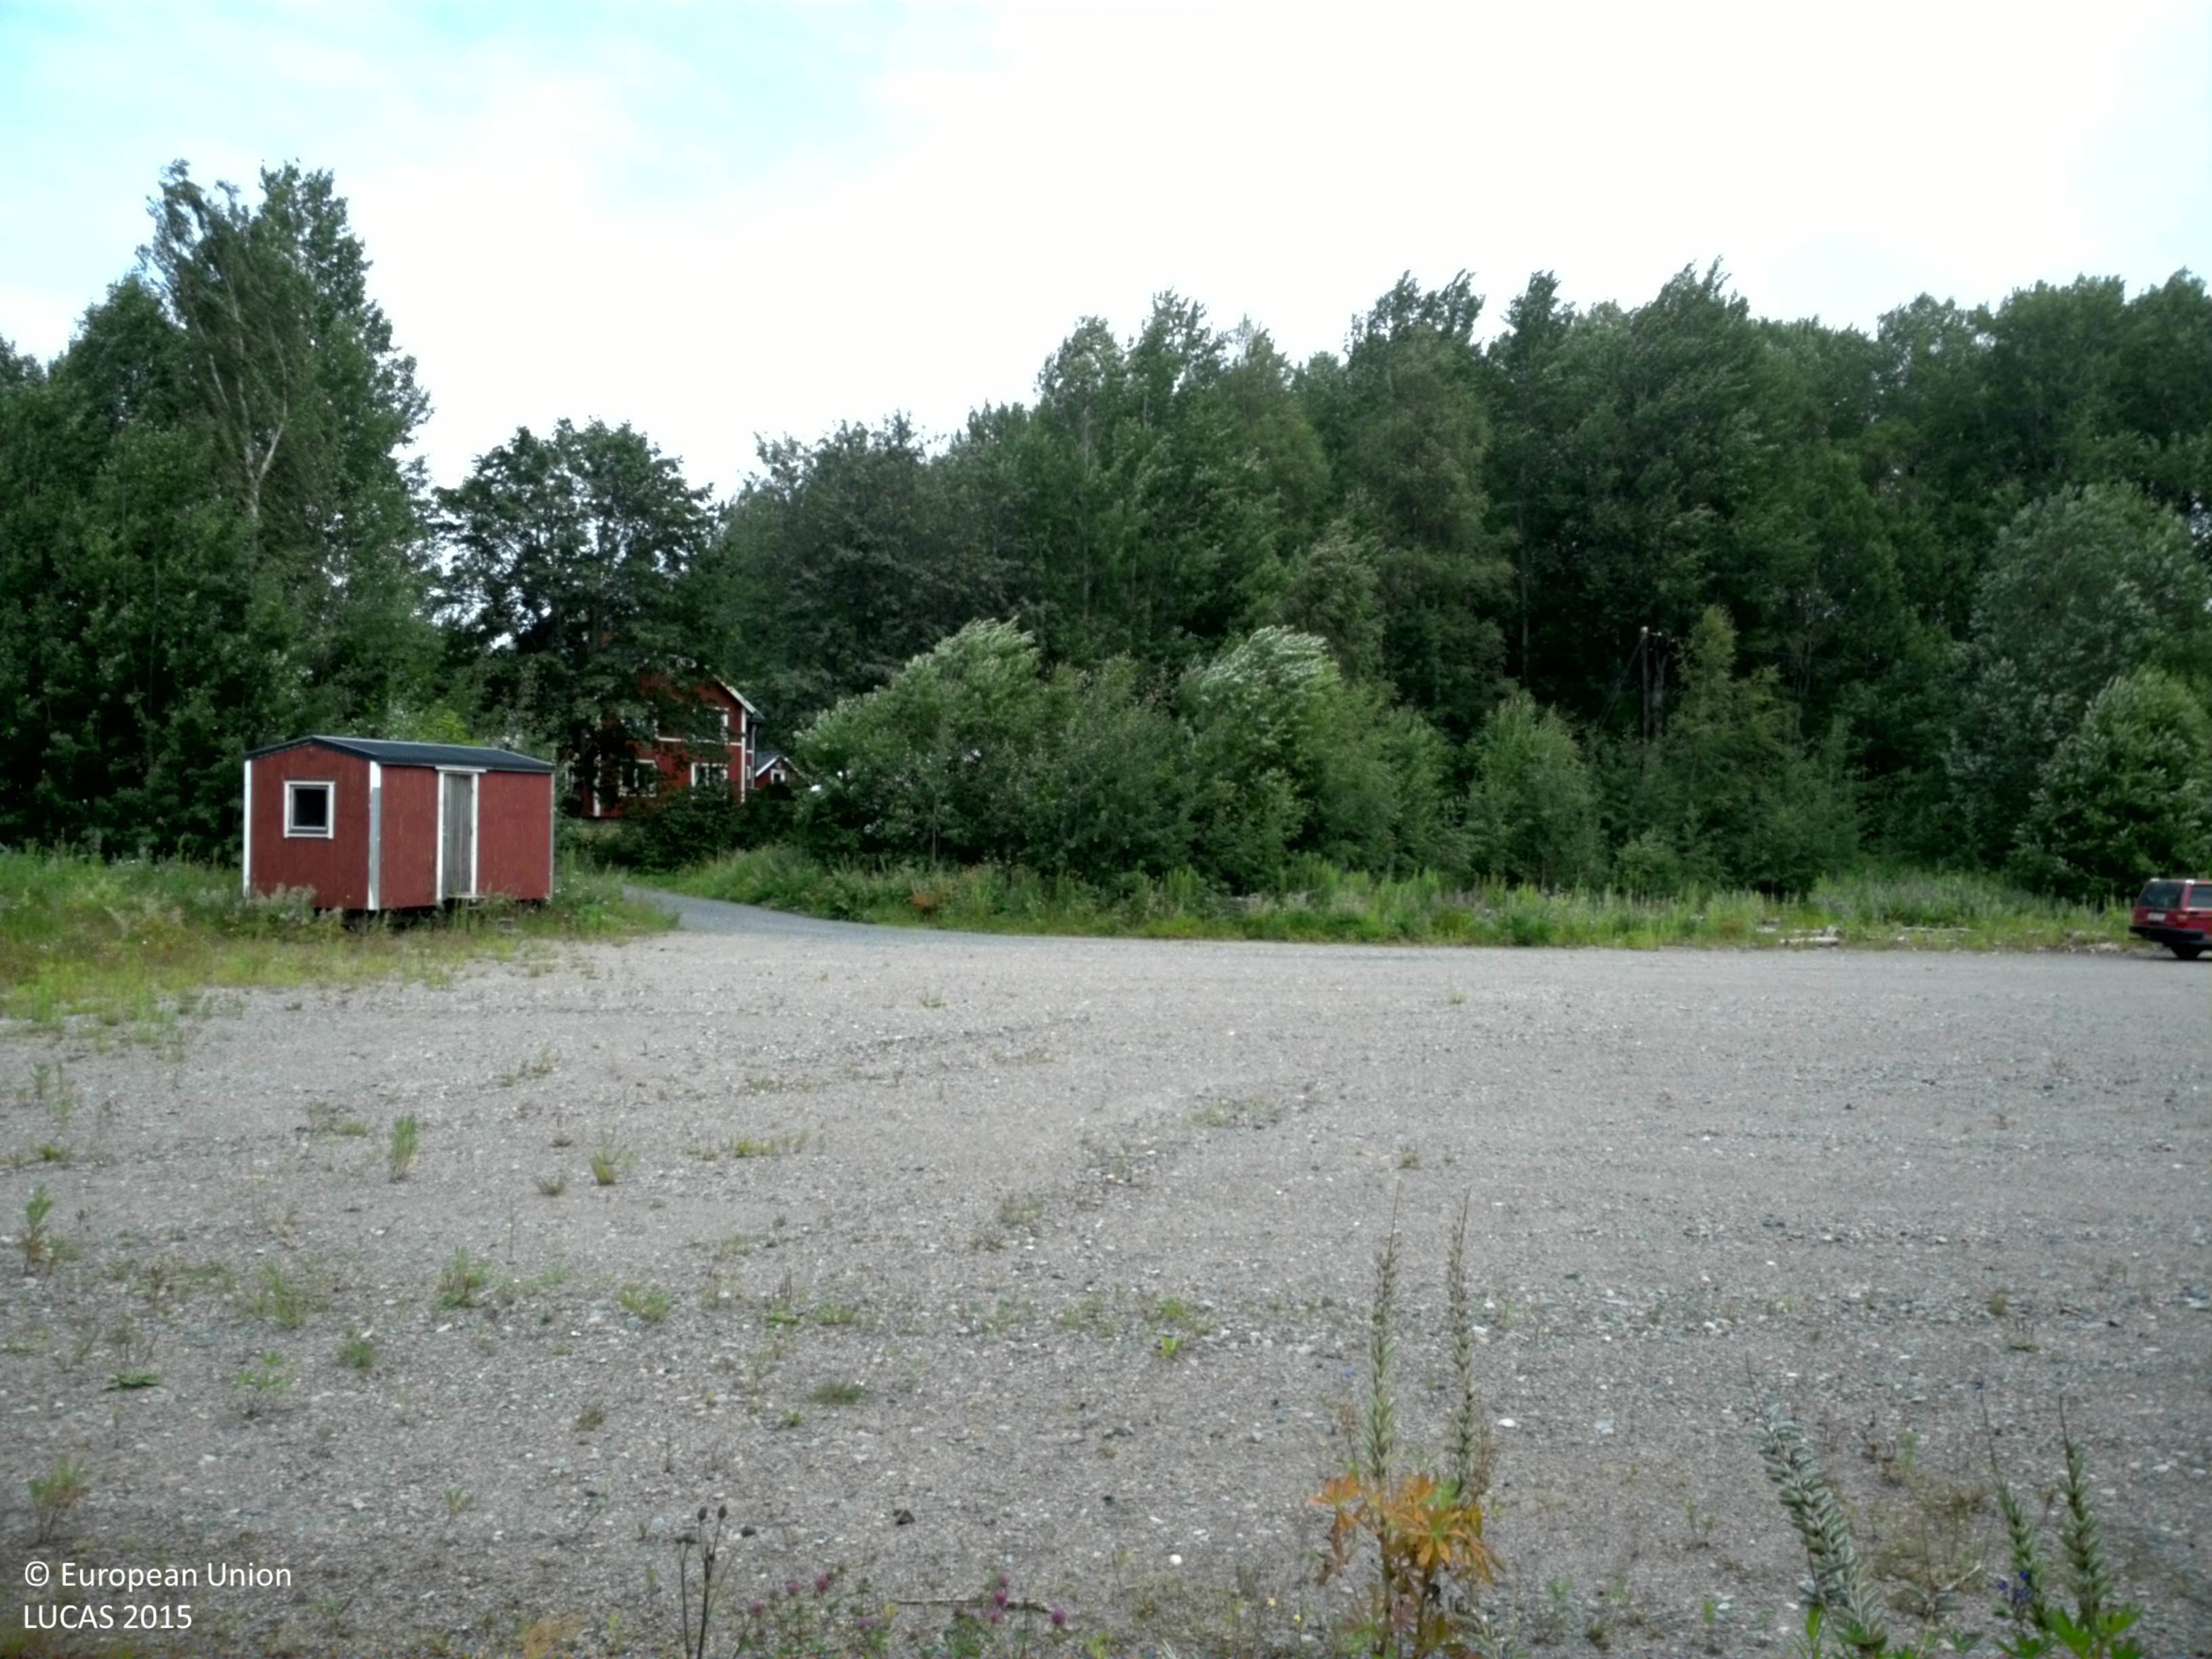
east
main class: Grassland
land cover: Grassland without tree/shrub cover
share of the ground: > 75 %
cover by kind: herbaceous plants 90 %, shrubs 5 %, unconsolidated bare surface 5 %
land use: Semi-natural and natural areas not in use
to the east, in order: Grassland without tree/shrub cover; Artificial constructions in urban areas; Shrubland with sparse tree cover; Broadleaved woodland; Paved roads, cycling and walking lanes; Fences; Grassland without tree/shrub cover; Ditches and canals; Grassland without tree/shrub cover; Grassland with sparse tree/shrub cover
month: July
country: SE
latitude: 57.5061
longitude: 14.7191
